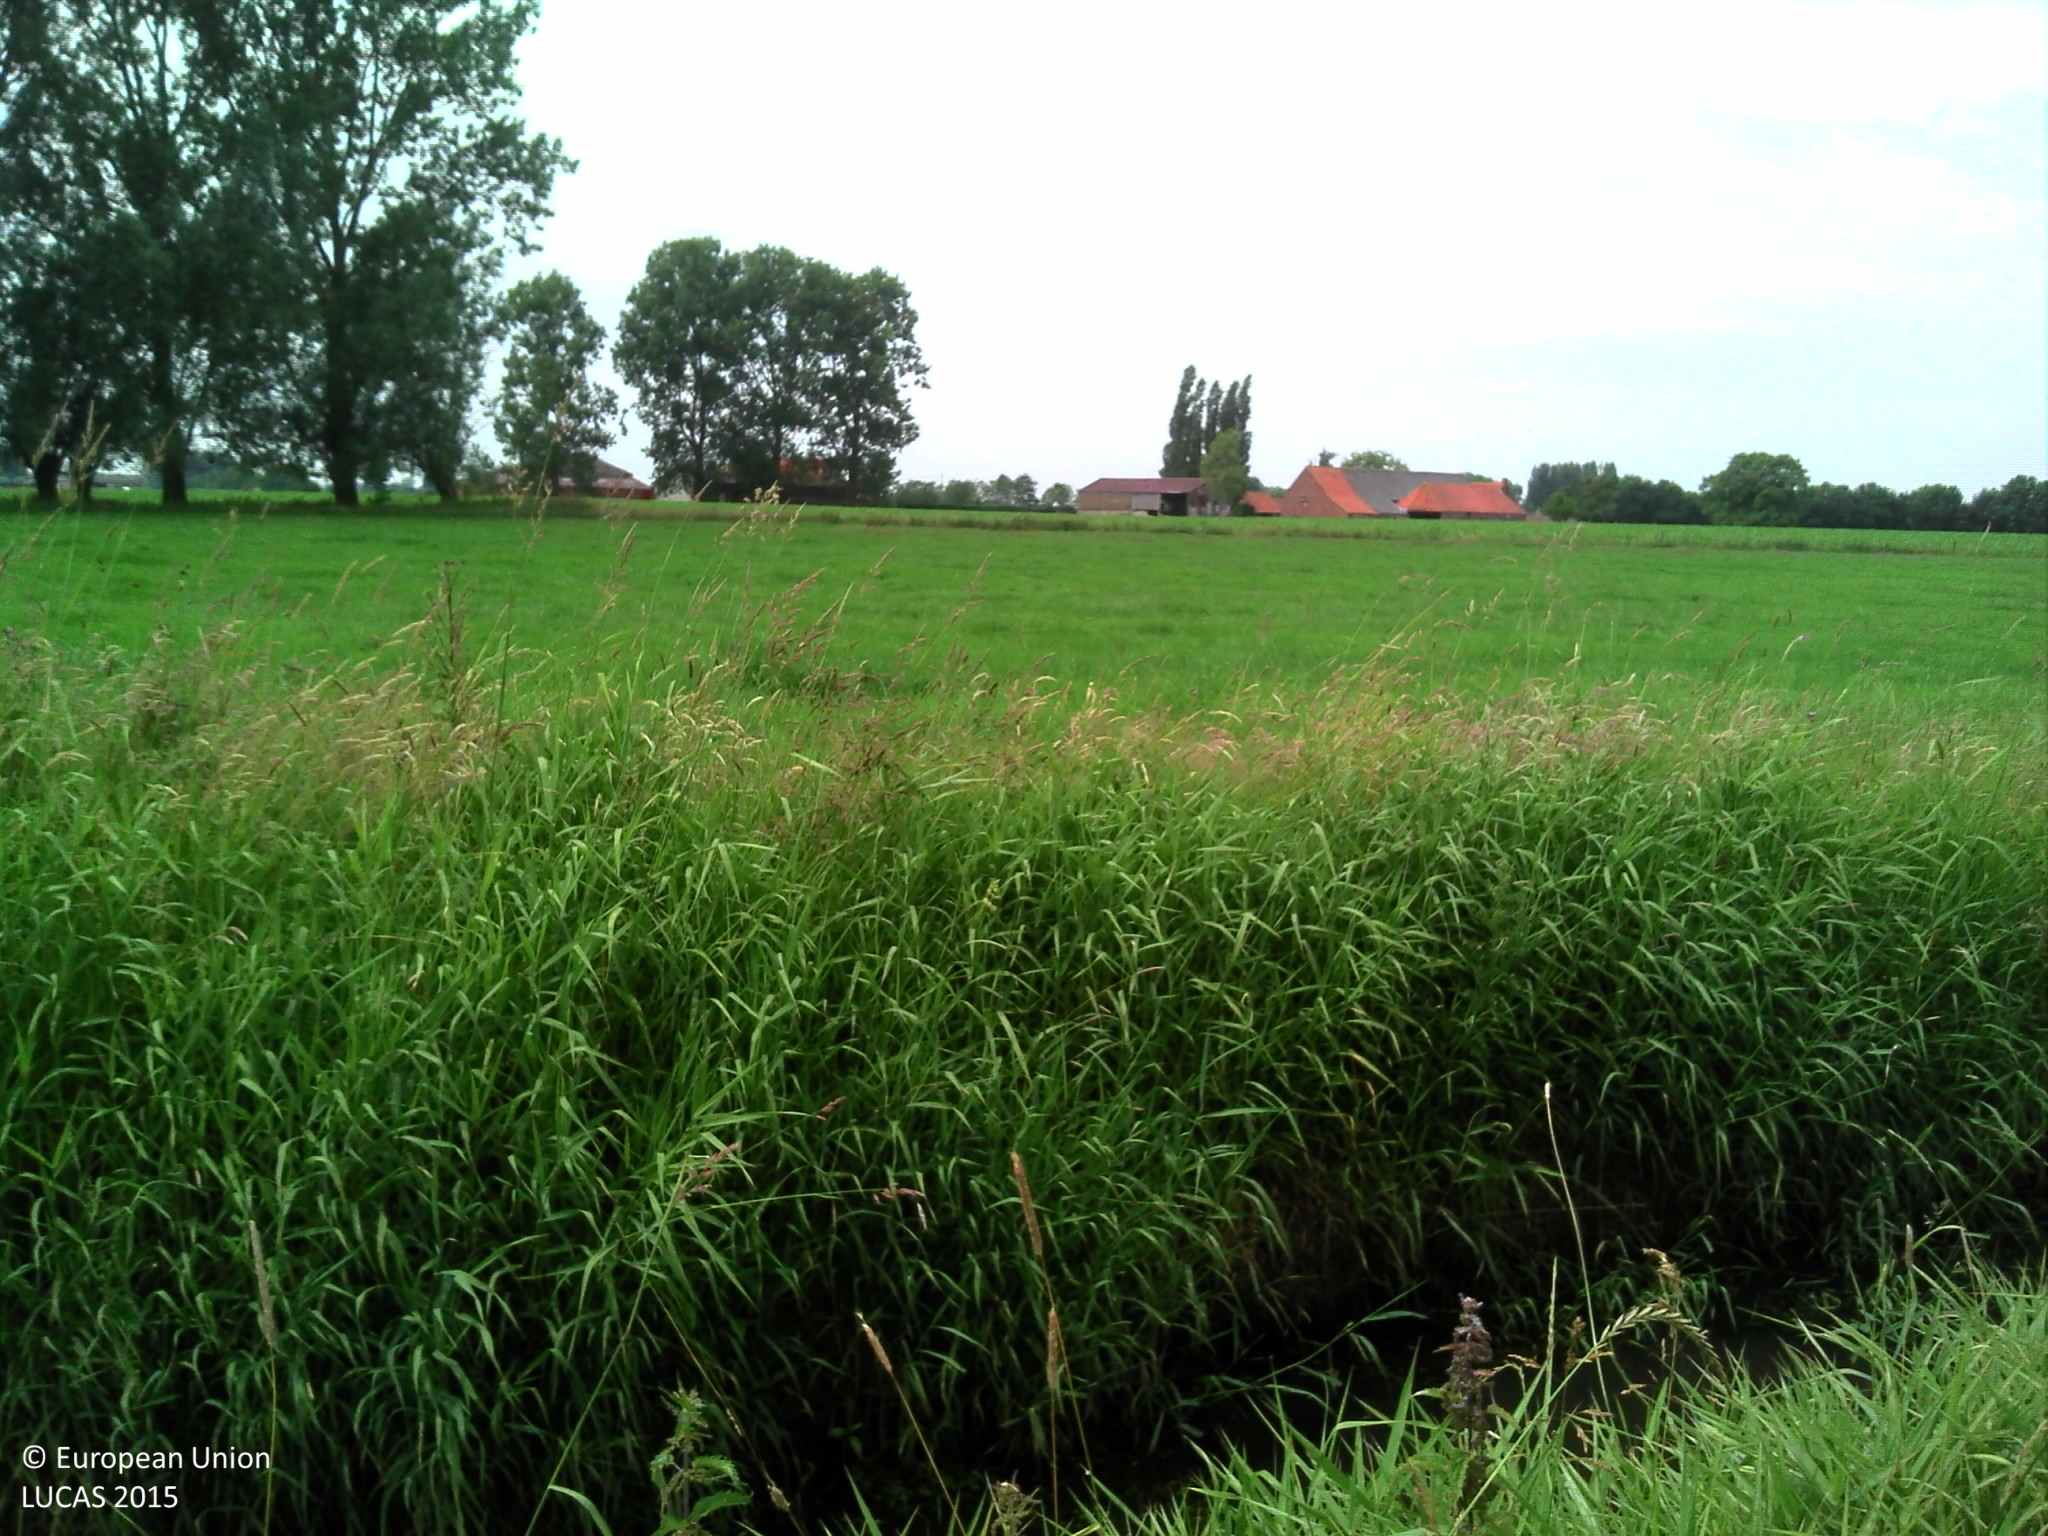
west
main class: Grassland
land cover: Grassland without tree/shrub cover
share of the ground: > 75 %
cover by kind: herbaceous plants 100 %
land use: Agriculture (excluding fallow land and kitchen gardens)
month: June
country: BE
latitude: 50.9704
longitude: 3.4556
